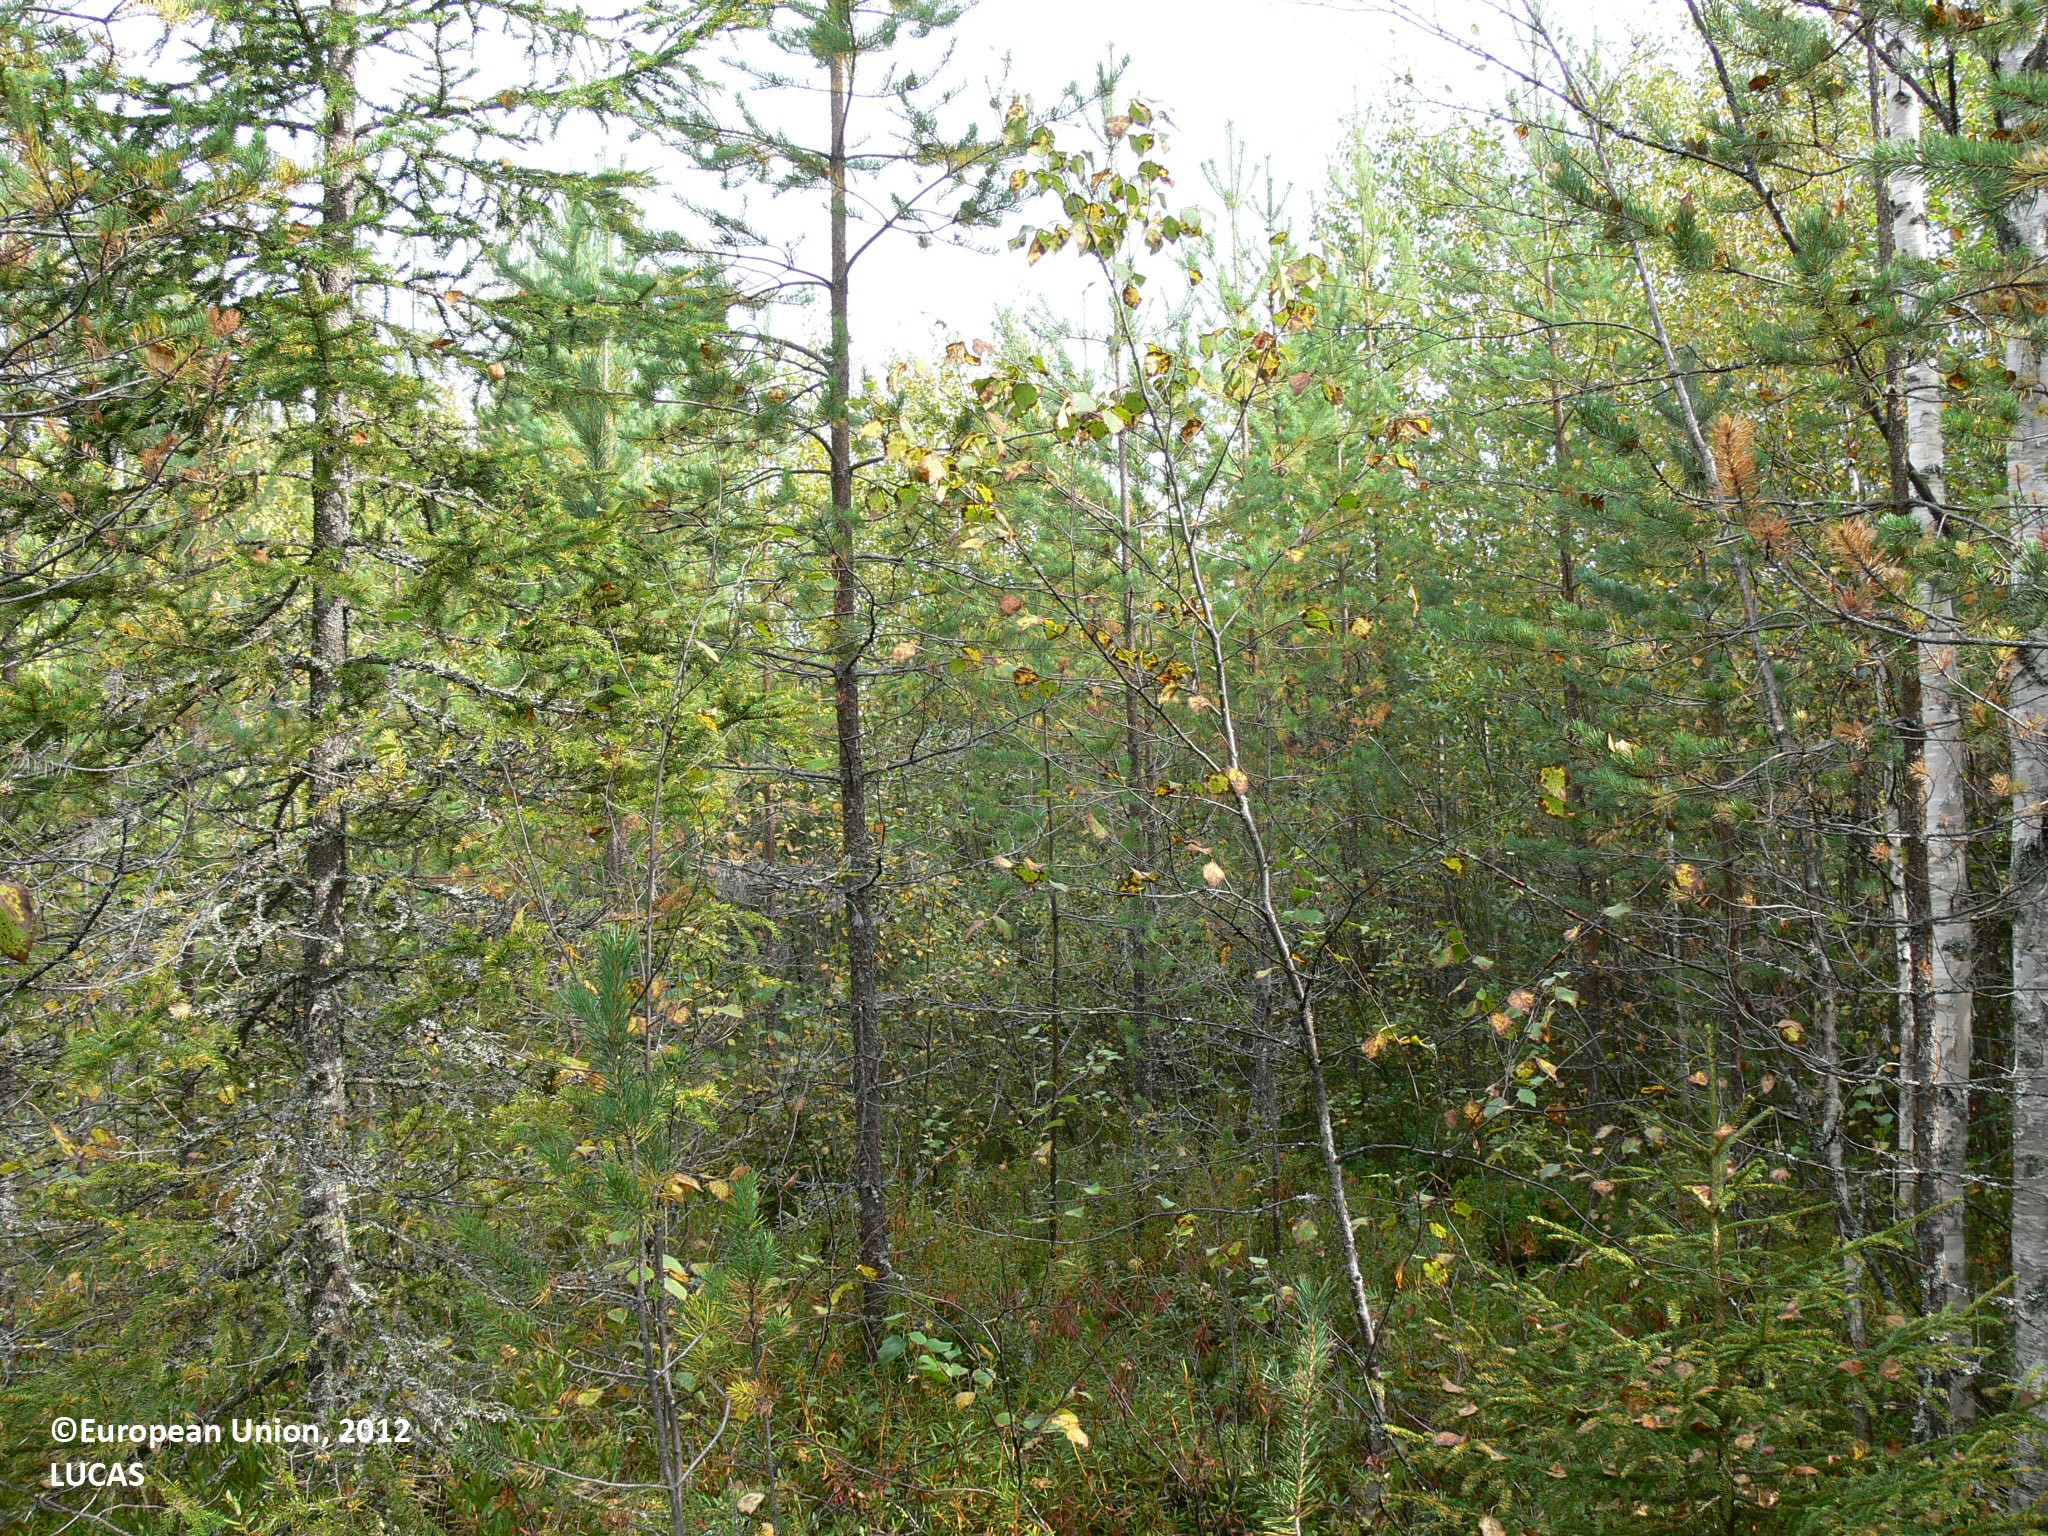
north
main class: Woodland
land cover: Pine dominated mixed woodland
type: boreal forest
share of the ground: > 75 %
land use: Forestry
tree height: < 5 m
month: September
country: FI
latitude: 63.0905
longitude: 30.0815
